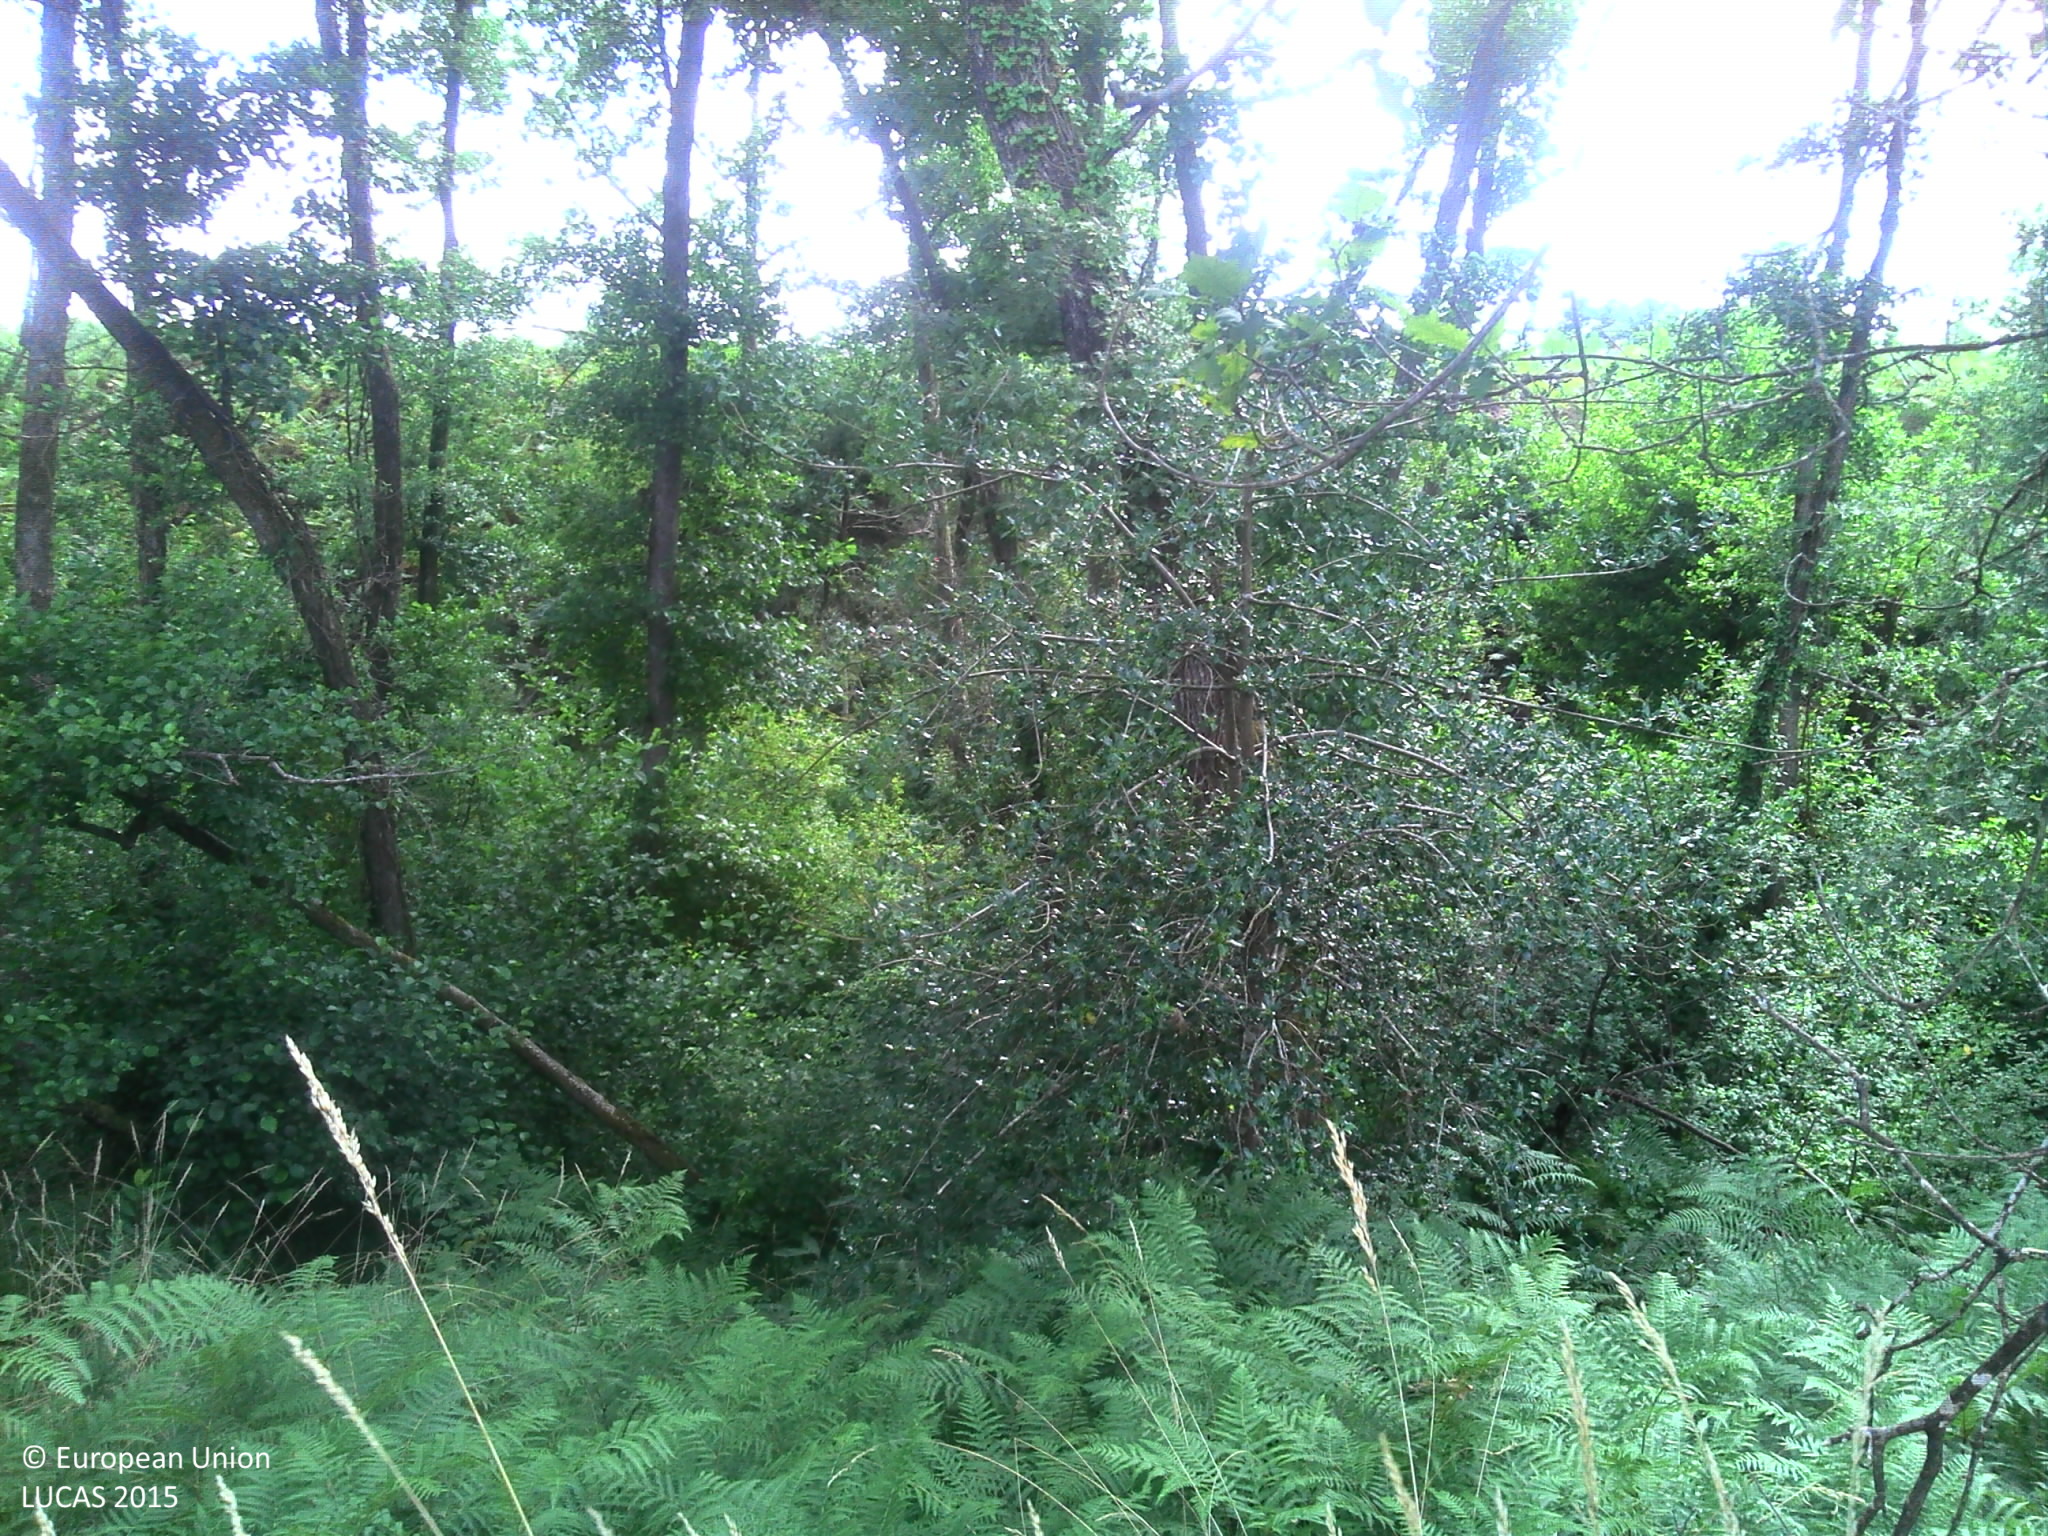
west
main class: Woodland
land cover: Broadleaved woodland
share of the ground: > 75 %
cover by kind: broadleaved forest trees 75 %, shrubs 15 %, herbaceous plants 10 %
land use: Semi-natural and natural areas not in use
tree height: > 5 m
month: July
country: FR
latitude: 44.0057
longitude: -0.7785
